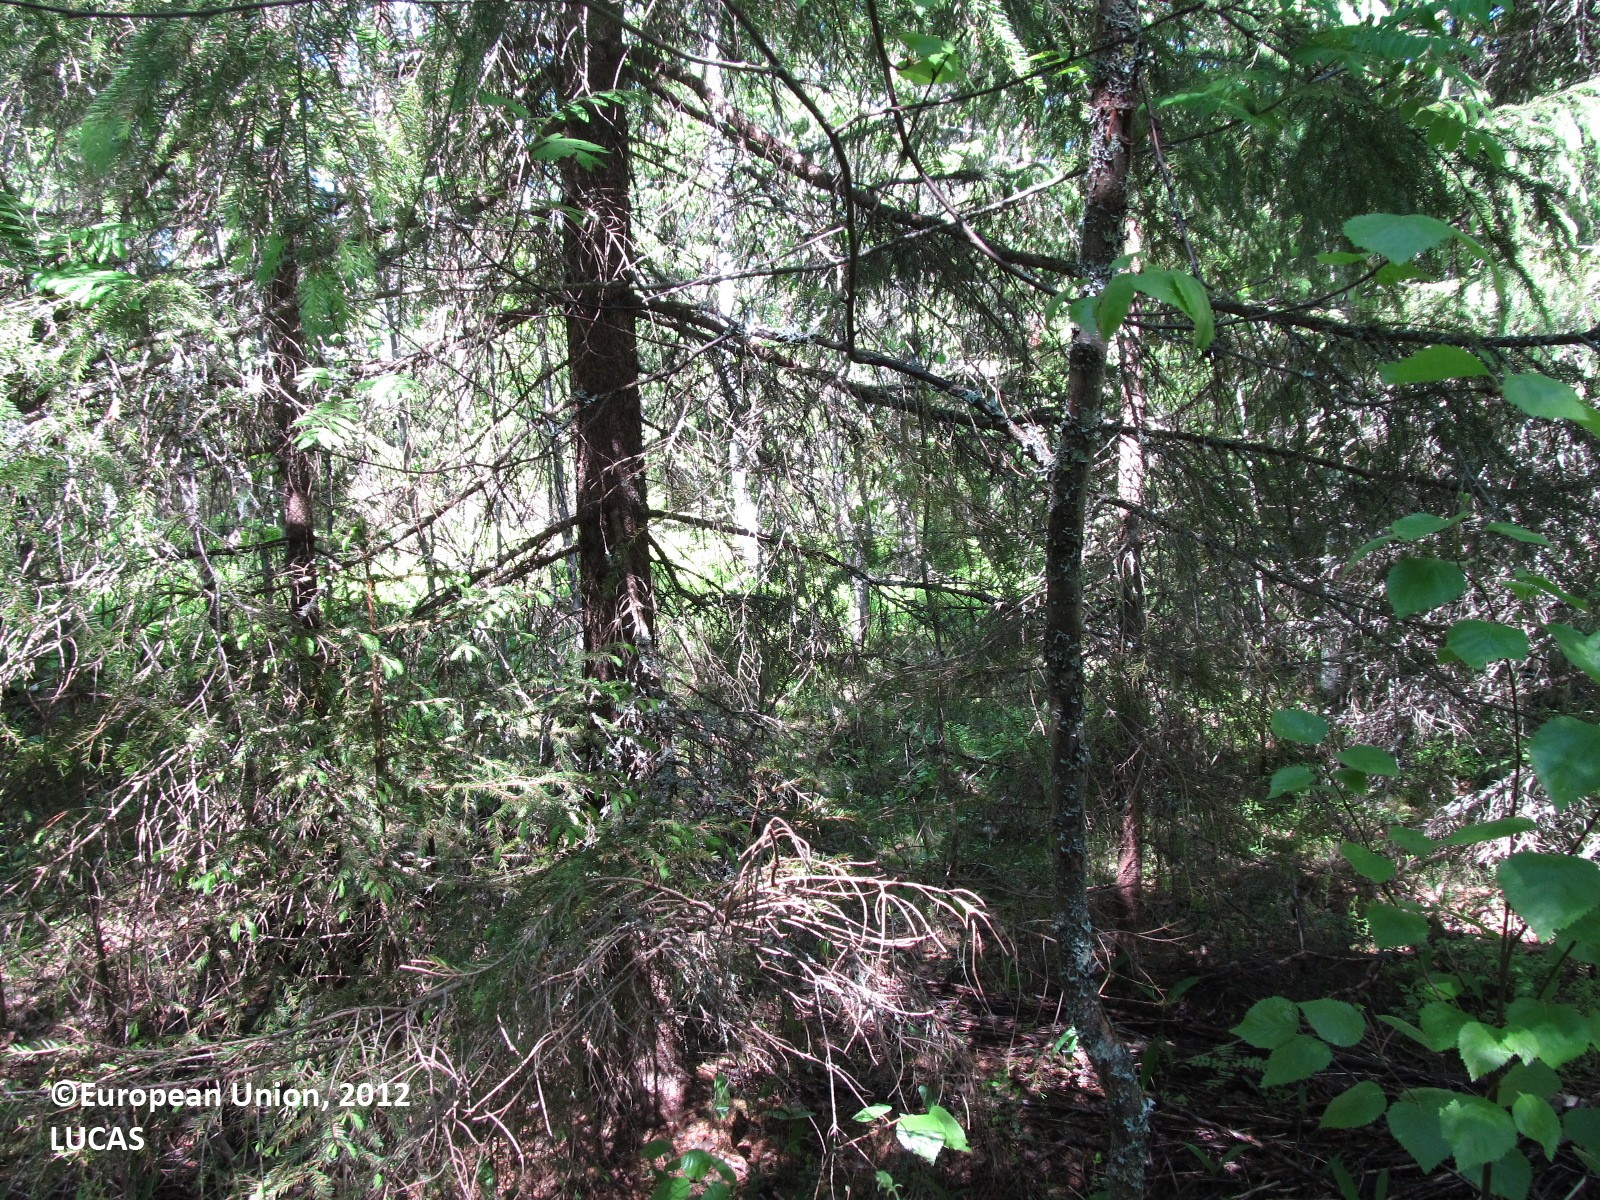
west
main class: Woodland
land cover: Spruce dominated mixed woodland
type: boreal forest
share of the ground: > 75 %
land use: Forestry
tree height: > 5 m
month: June
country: FI
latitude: 62.7197
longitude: 27.3907
